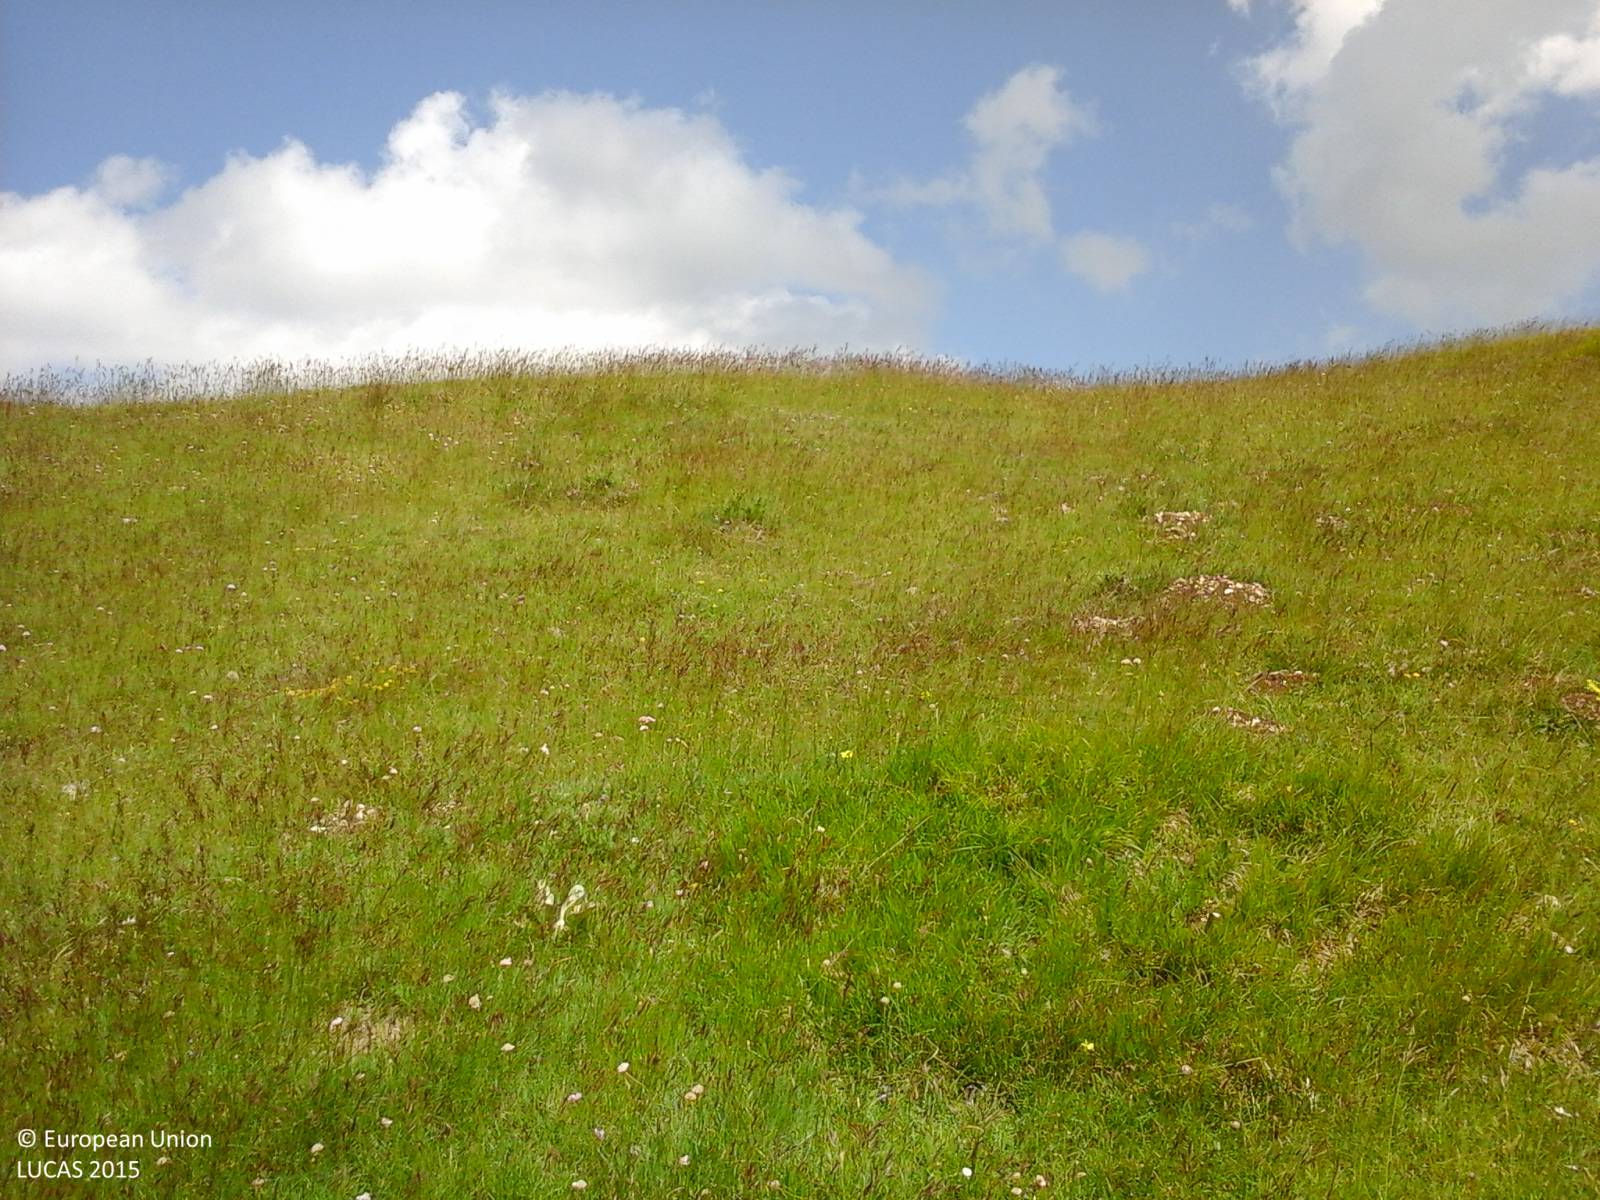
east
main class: Grassland
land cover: Grassland without tree/shrub cover
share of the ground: > 75 %
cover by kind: herbaceous plants 100 %
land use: Agriculture (excluding fallow land and kitchen gardens)
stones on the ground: 10 - 25 %
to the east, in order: Grassland without tree/shrub cover; Paved roads, cycling and walking lanes; Grassland without tree/shrub cover
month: June
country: IT
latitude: 42.4041
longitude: 13.7427
